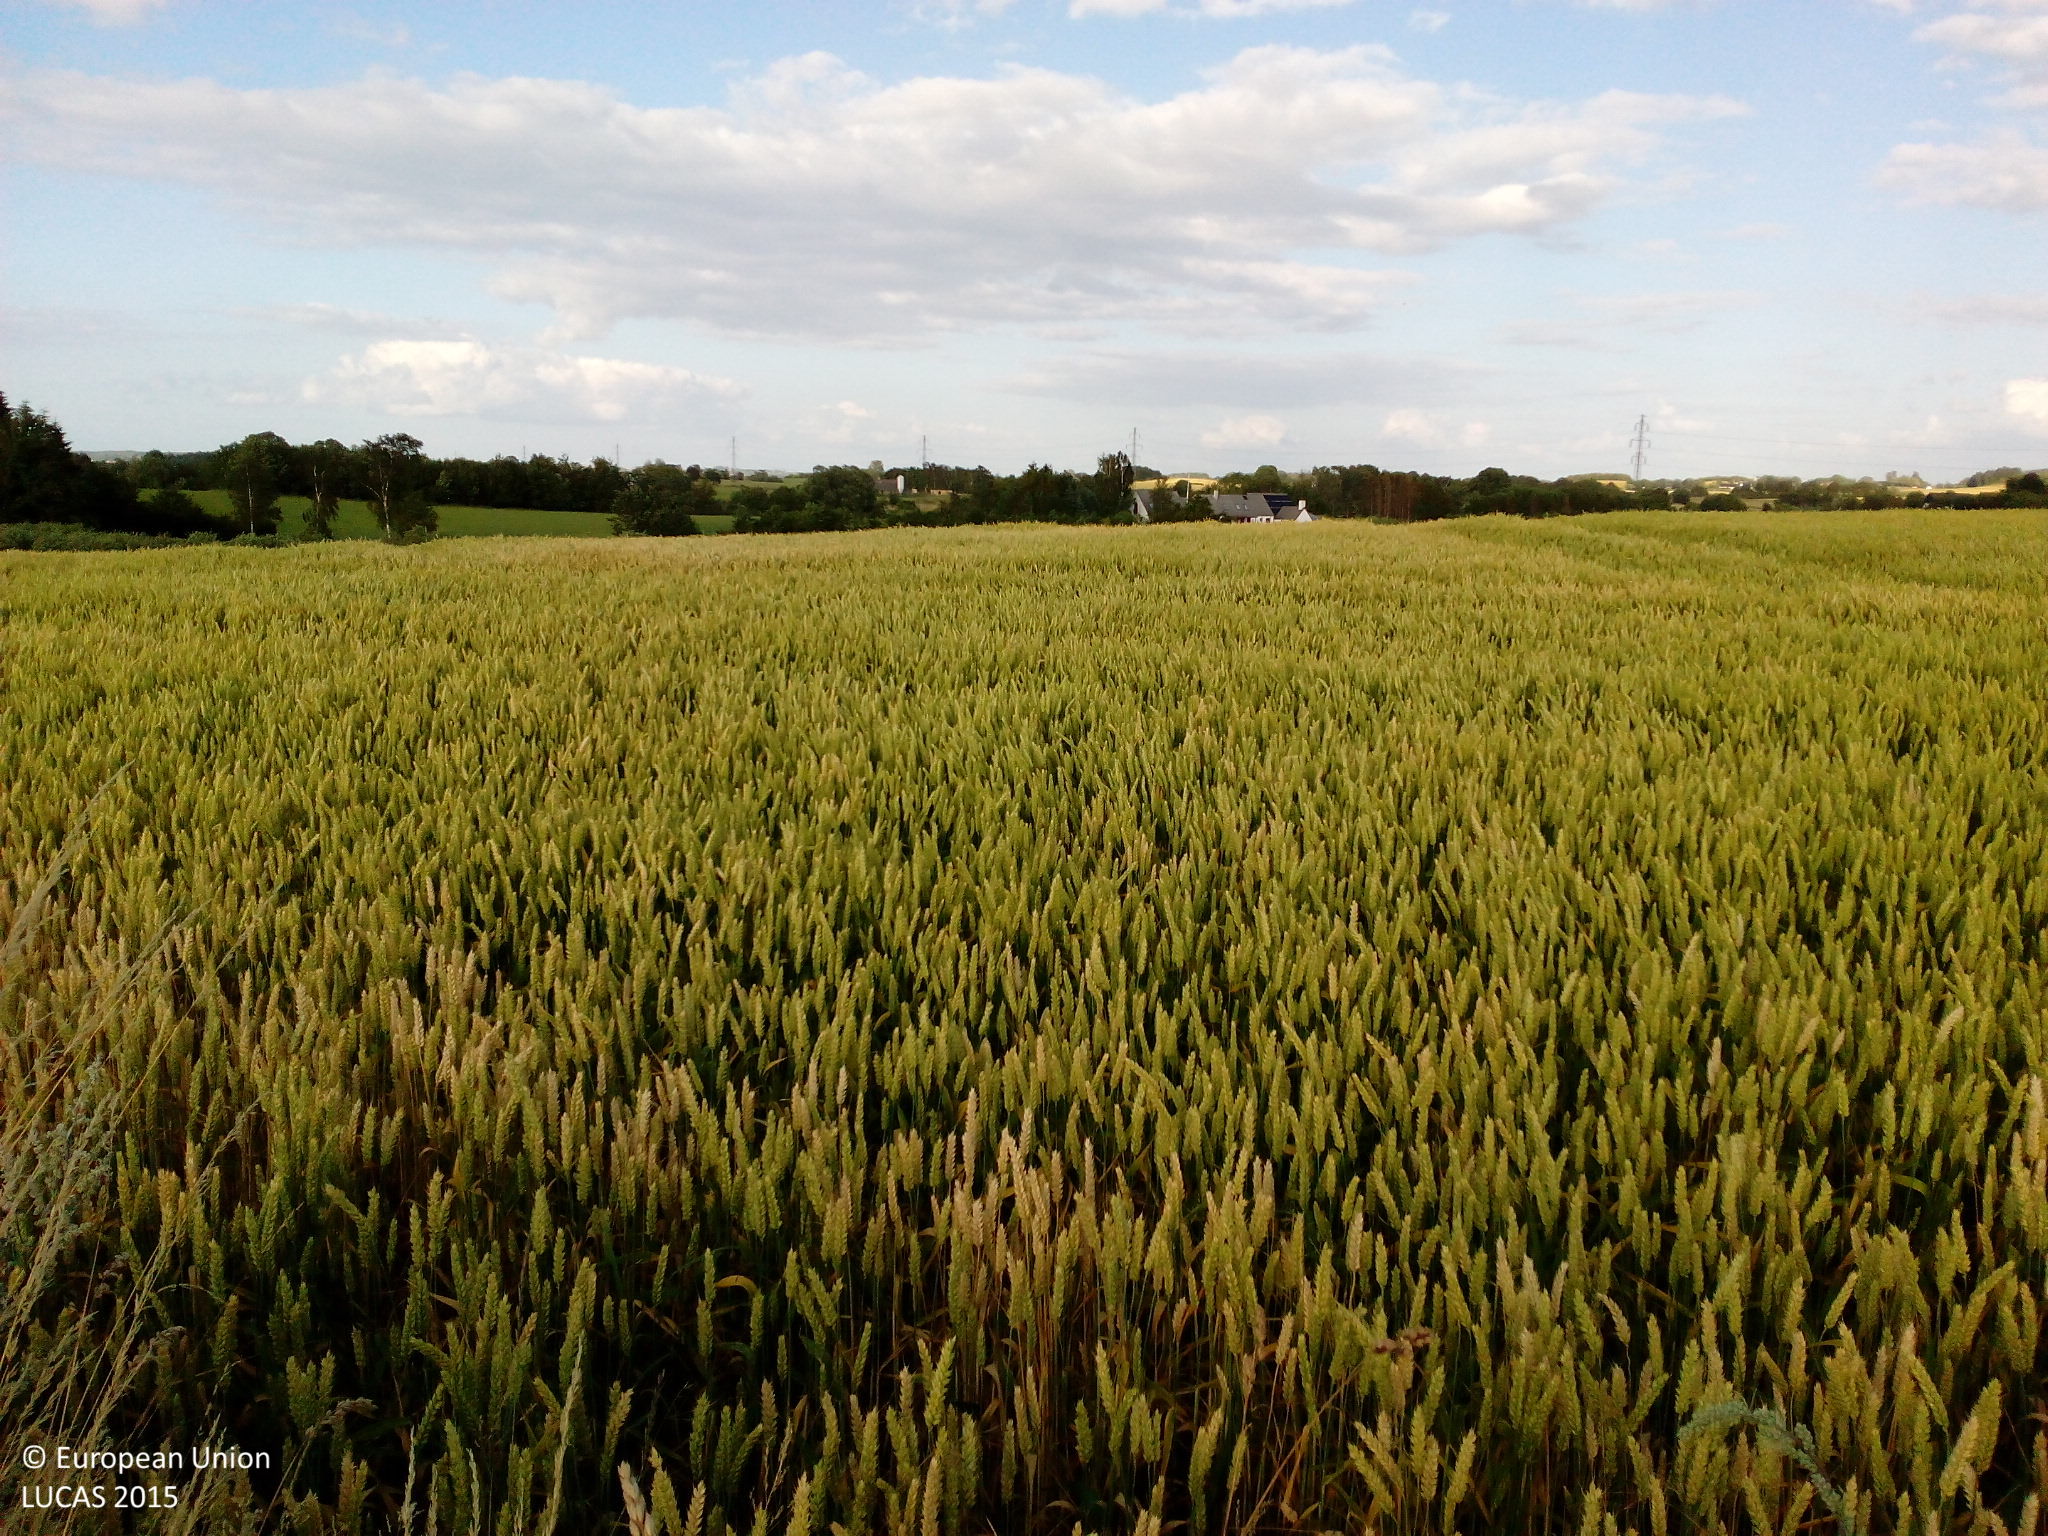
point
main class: Cropland
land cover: Common wheat
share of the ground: > 75 %
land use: Agriculture (excluding fallow land and kitchen gardens)
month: July
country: DK
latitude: 55.8189
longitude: 11.5466
